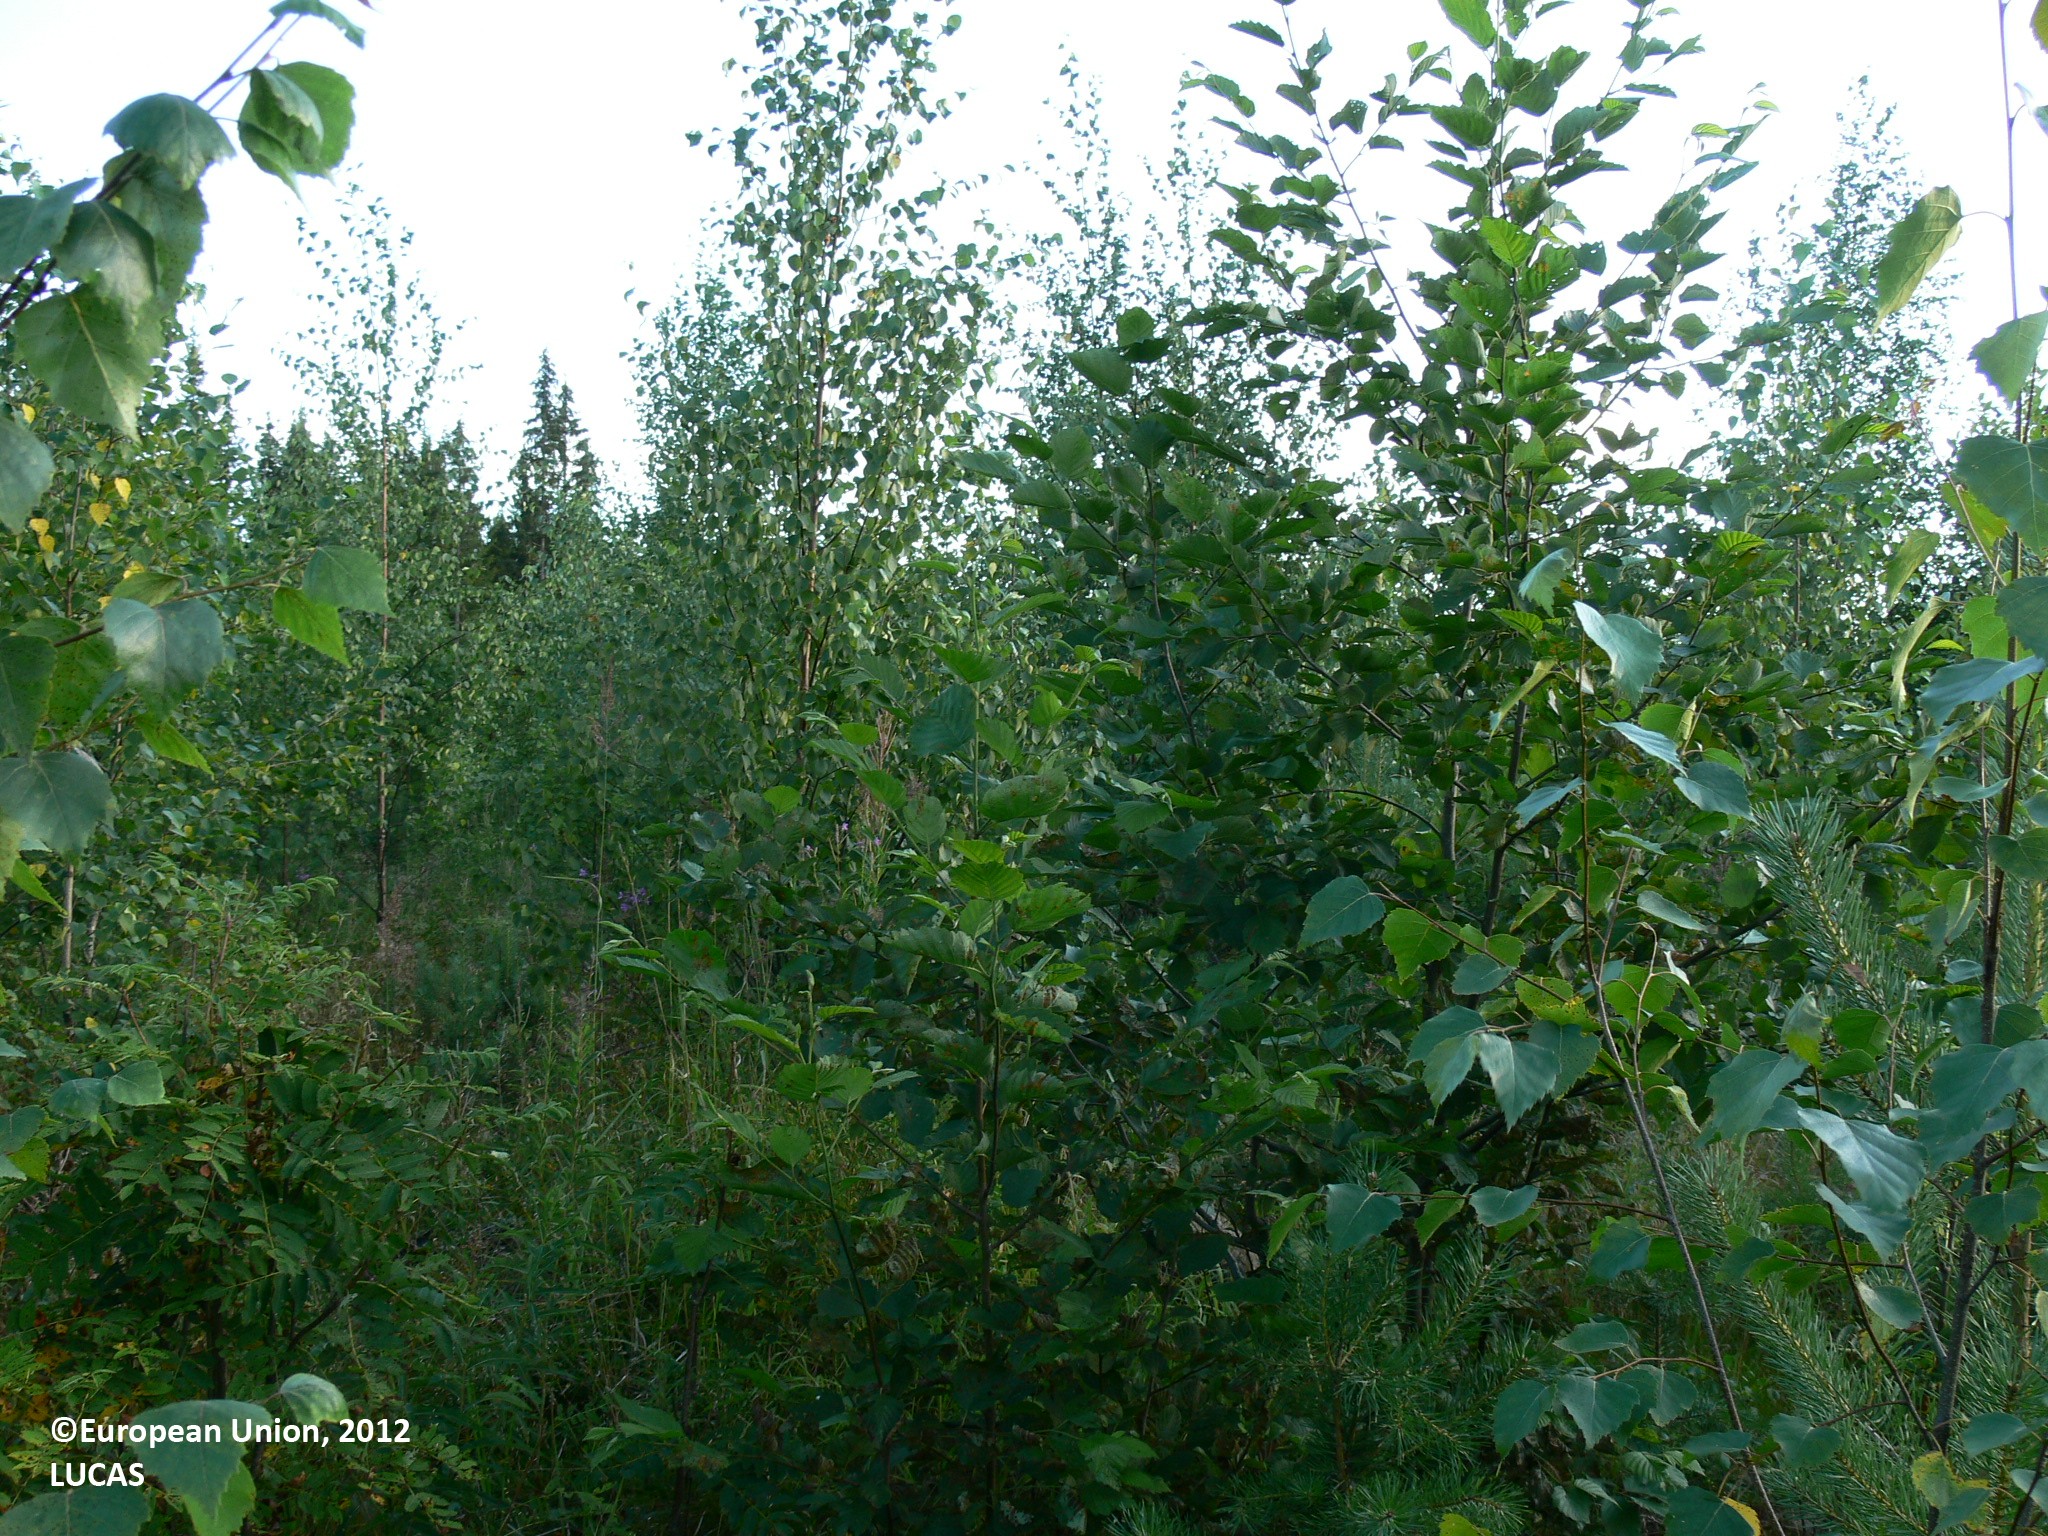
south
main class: Woodland
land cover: Pine dominated mixed woodland
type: boreal forest
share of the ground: 25 - 50 %
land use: Forestry
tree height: < 5 m
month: August
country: FI
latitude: 61.9582
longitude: 29.1665
